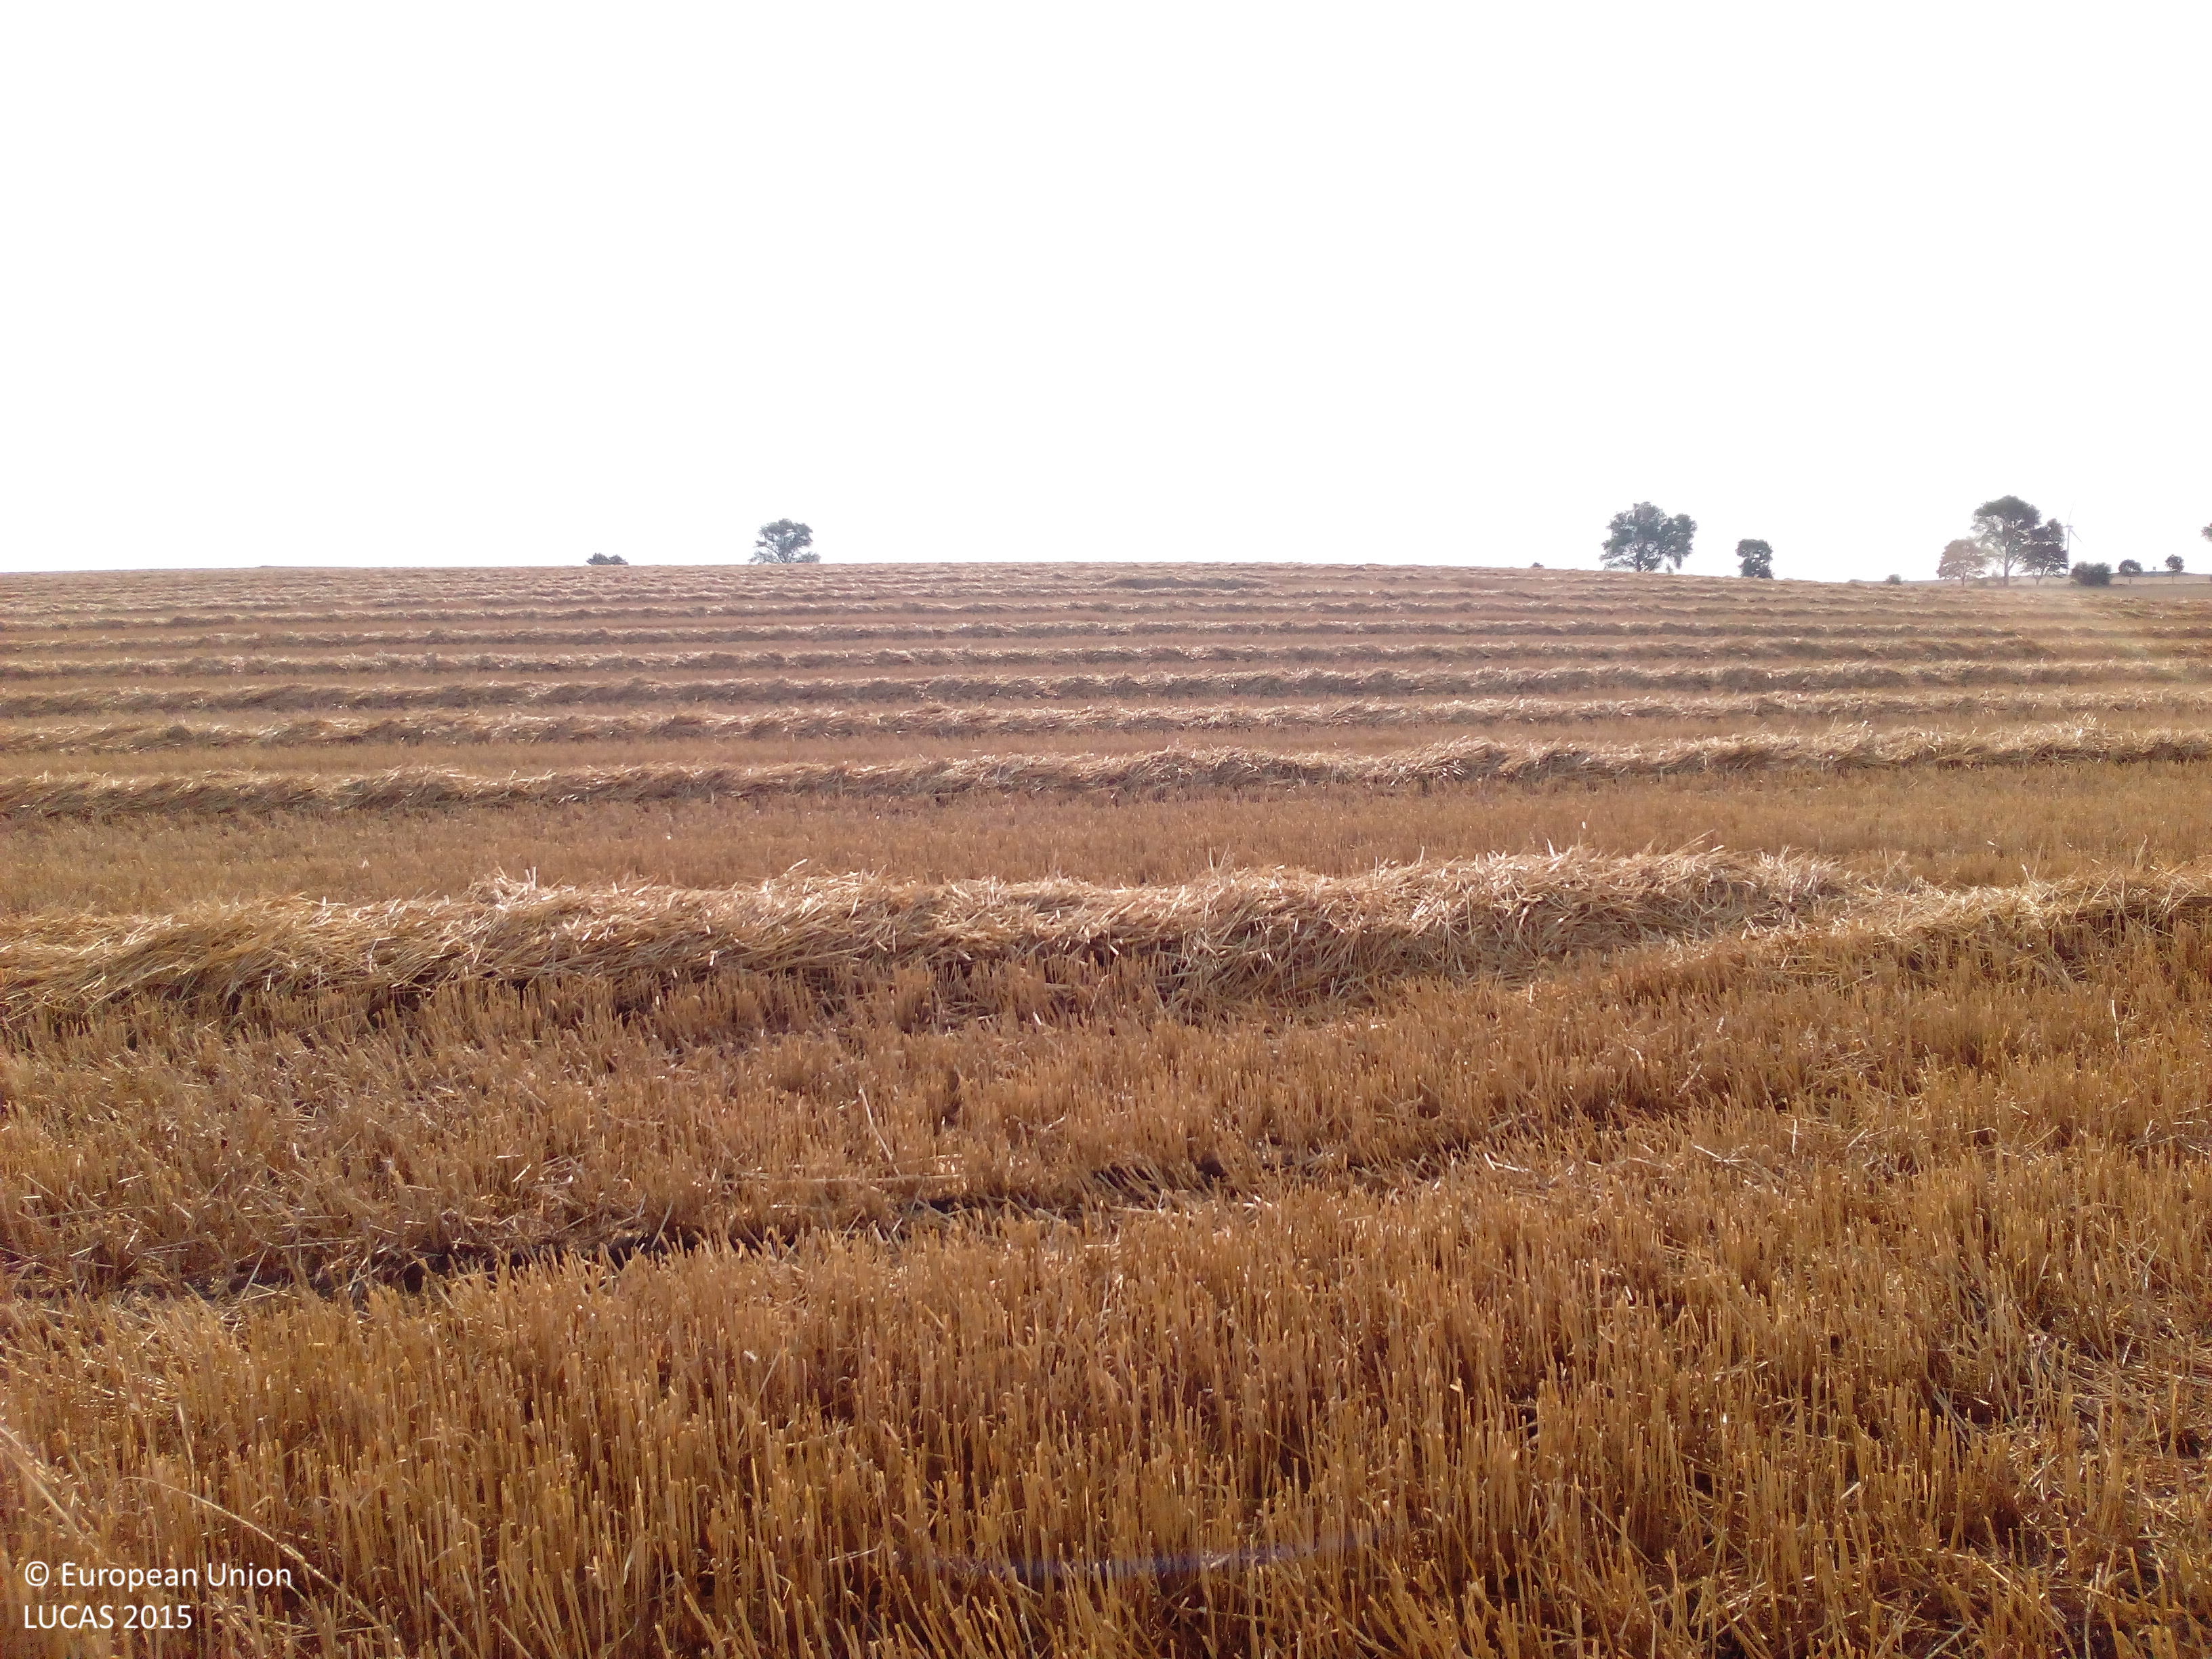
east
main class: Cropland
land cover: Common wheat
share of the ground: > 75 %
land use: Agriculture (excluding fallow land and kitchen gardens)
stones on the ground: < 10 %
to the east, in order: Common wheat
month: August
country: DE
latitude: 52.0127
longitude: 11.1215
